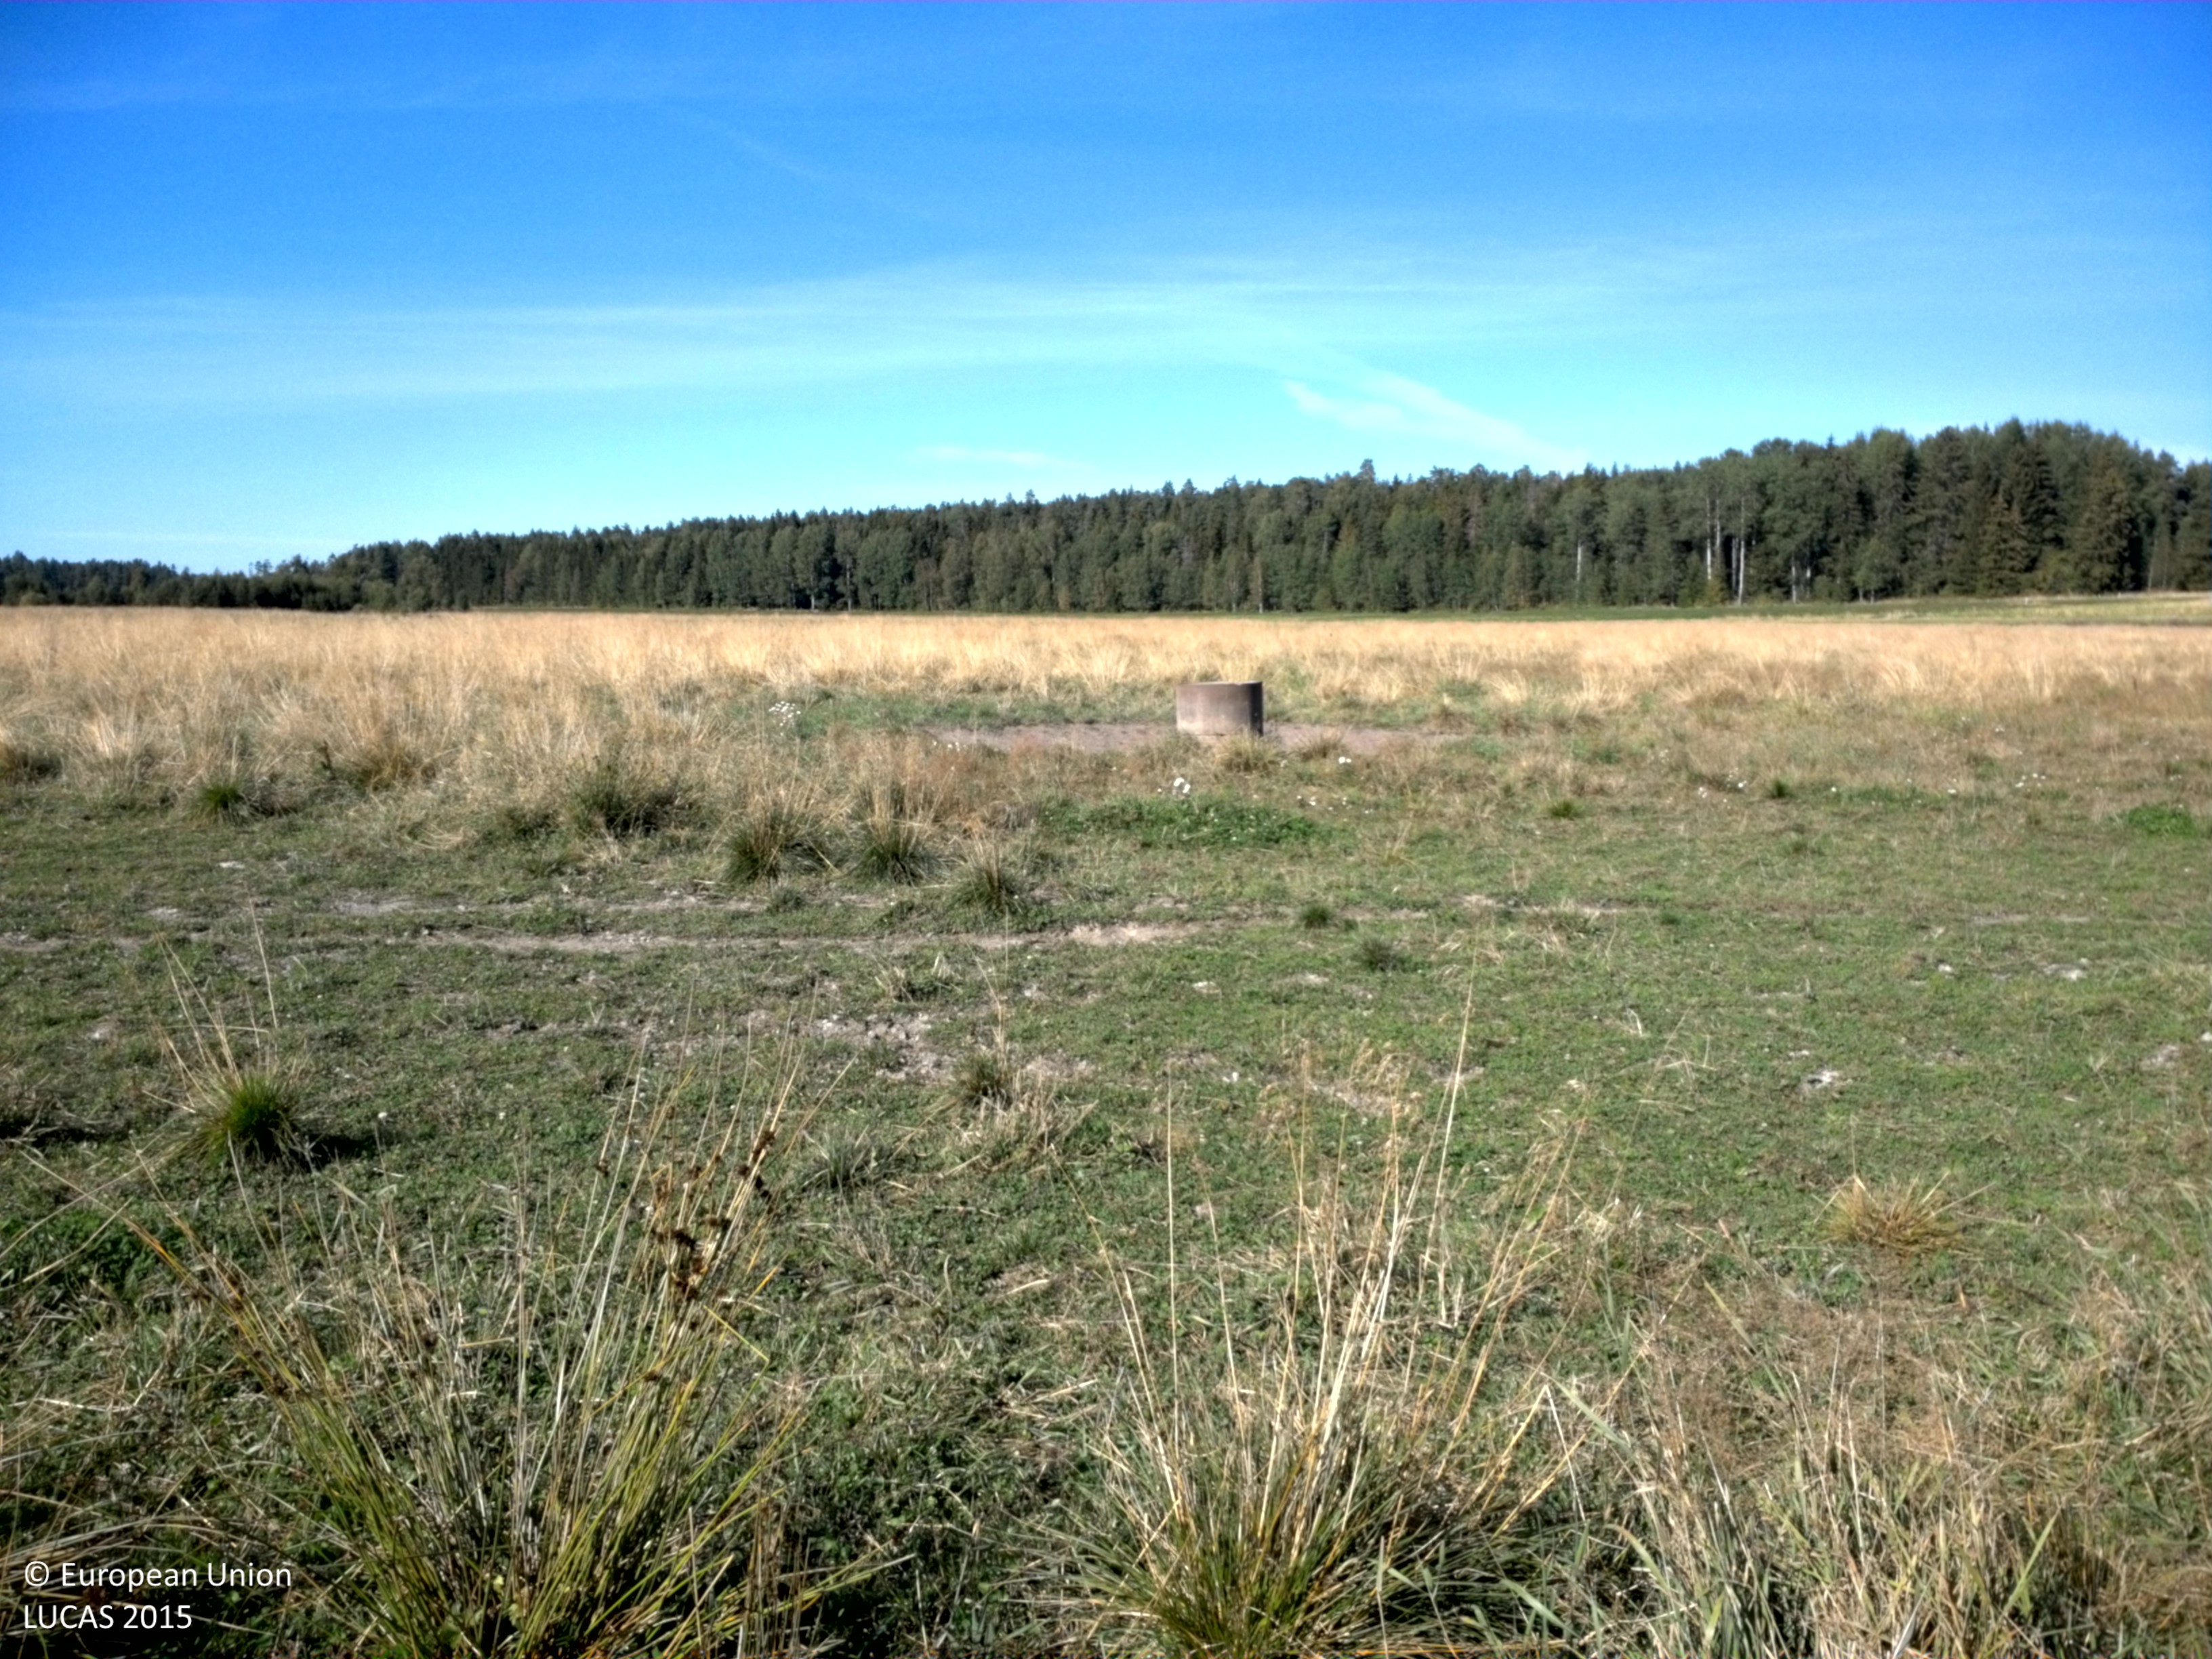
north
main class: Grassland
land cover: Grassland without tree/shrub cover
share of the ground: > 75 %
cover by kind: herbaceous plants 100 %
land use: Agriculture (excluding fallow land and kitchen gardens)
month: August
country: SE
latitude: 59.7937
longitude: 16.9241
